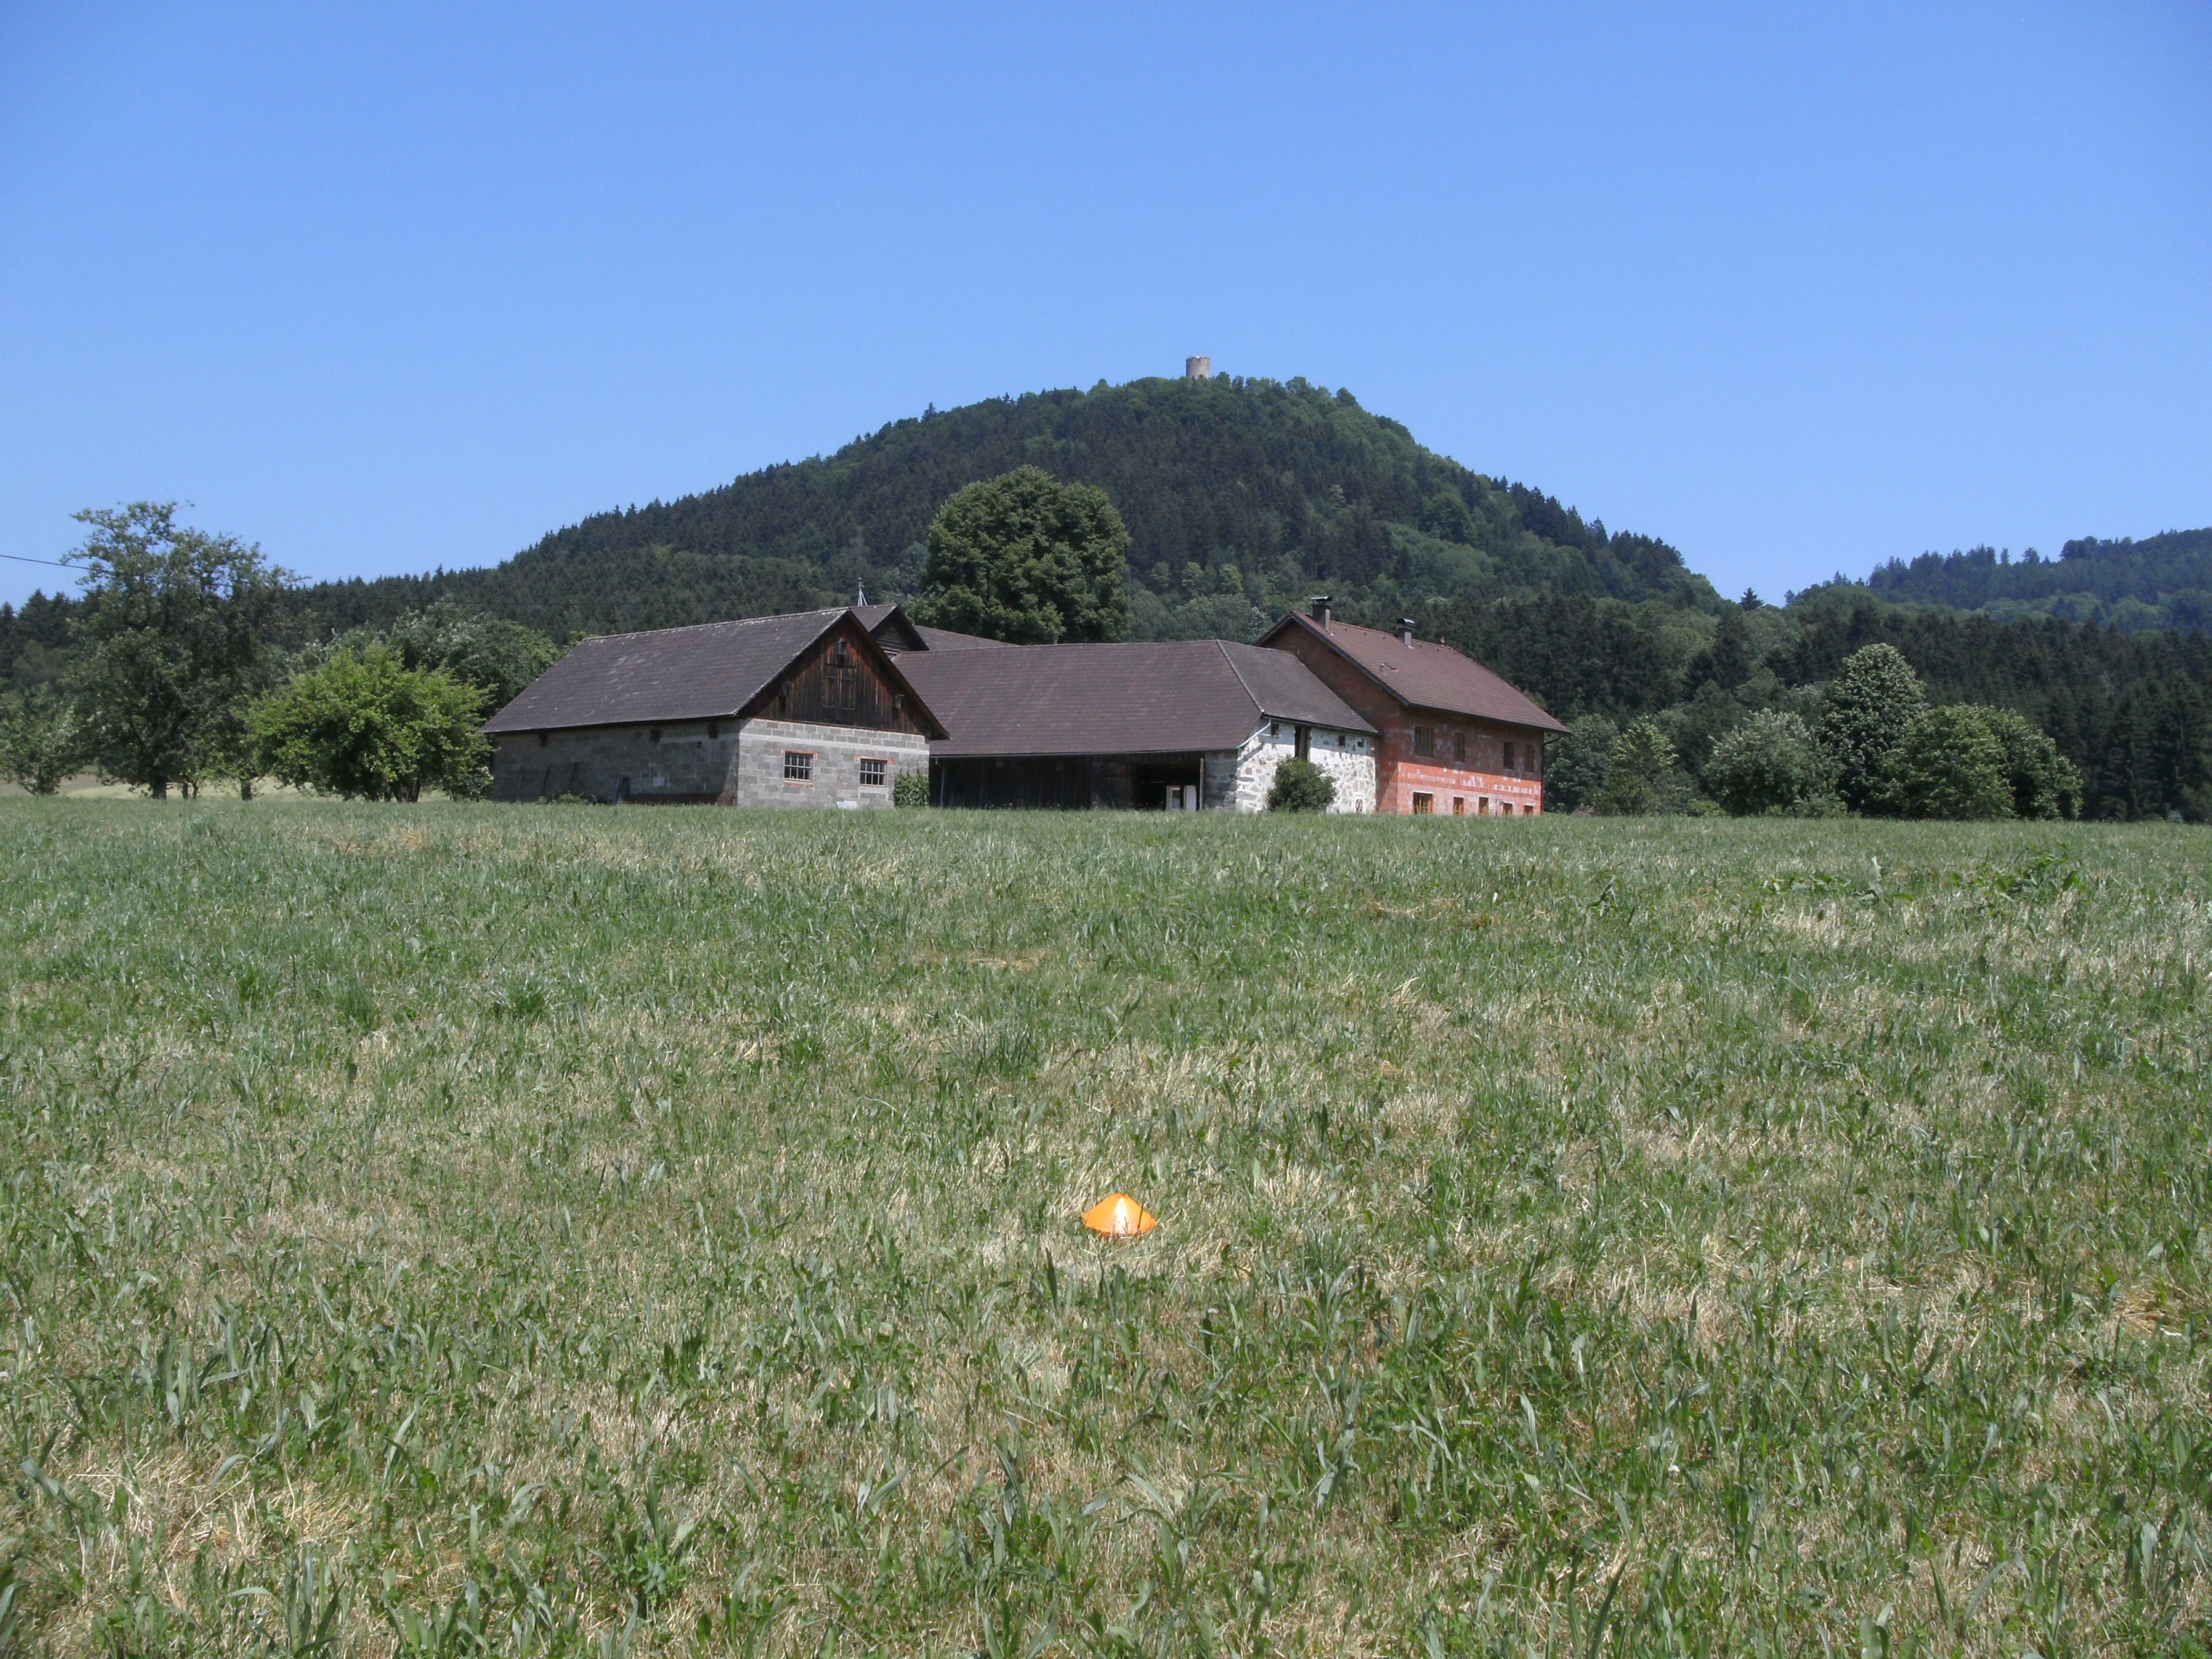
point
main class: Grassland
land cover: Grassland without tree/shrub cover
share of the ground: > 75 %
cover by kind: herbaceous plants 100 %
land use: Agriculture (excluding fallow land and kitchen gardens)
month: June
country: AT
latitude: 48.4686
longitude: 14.1795
